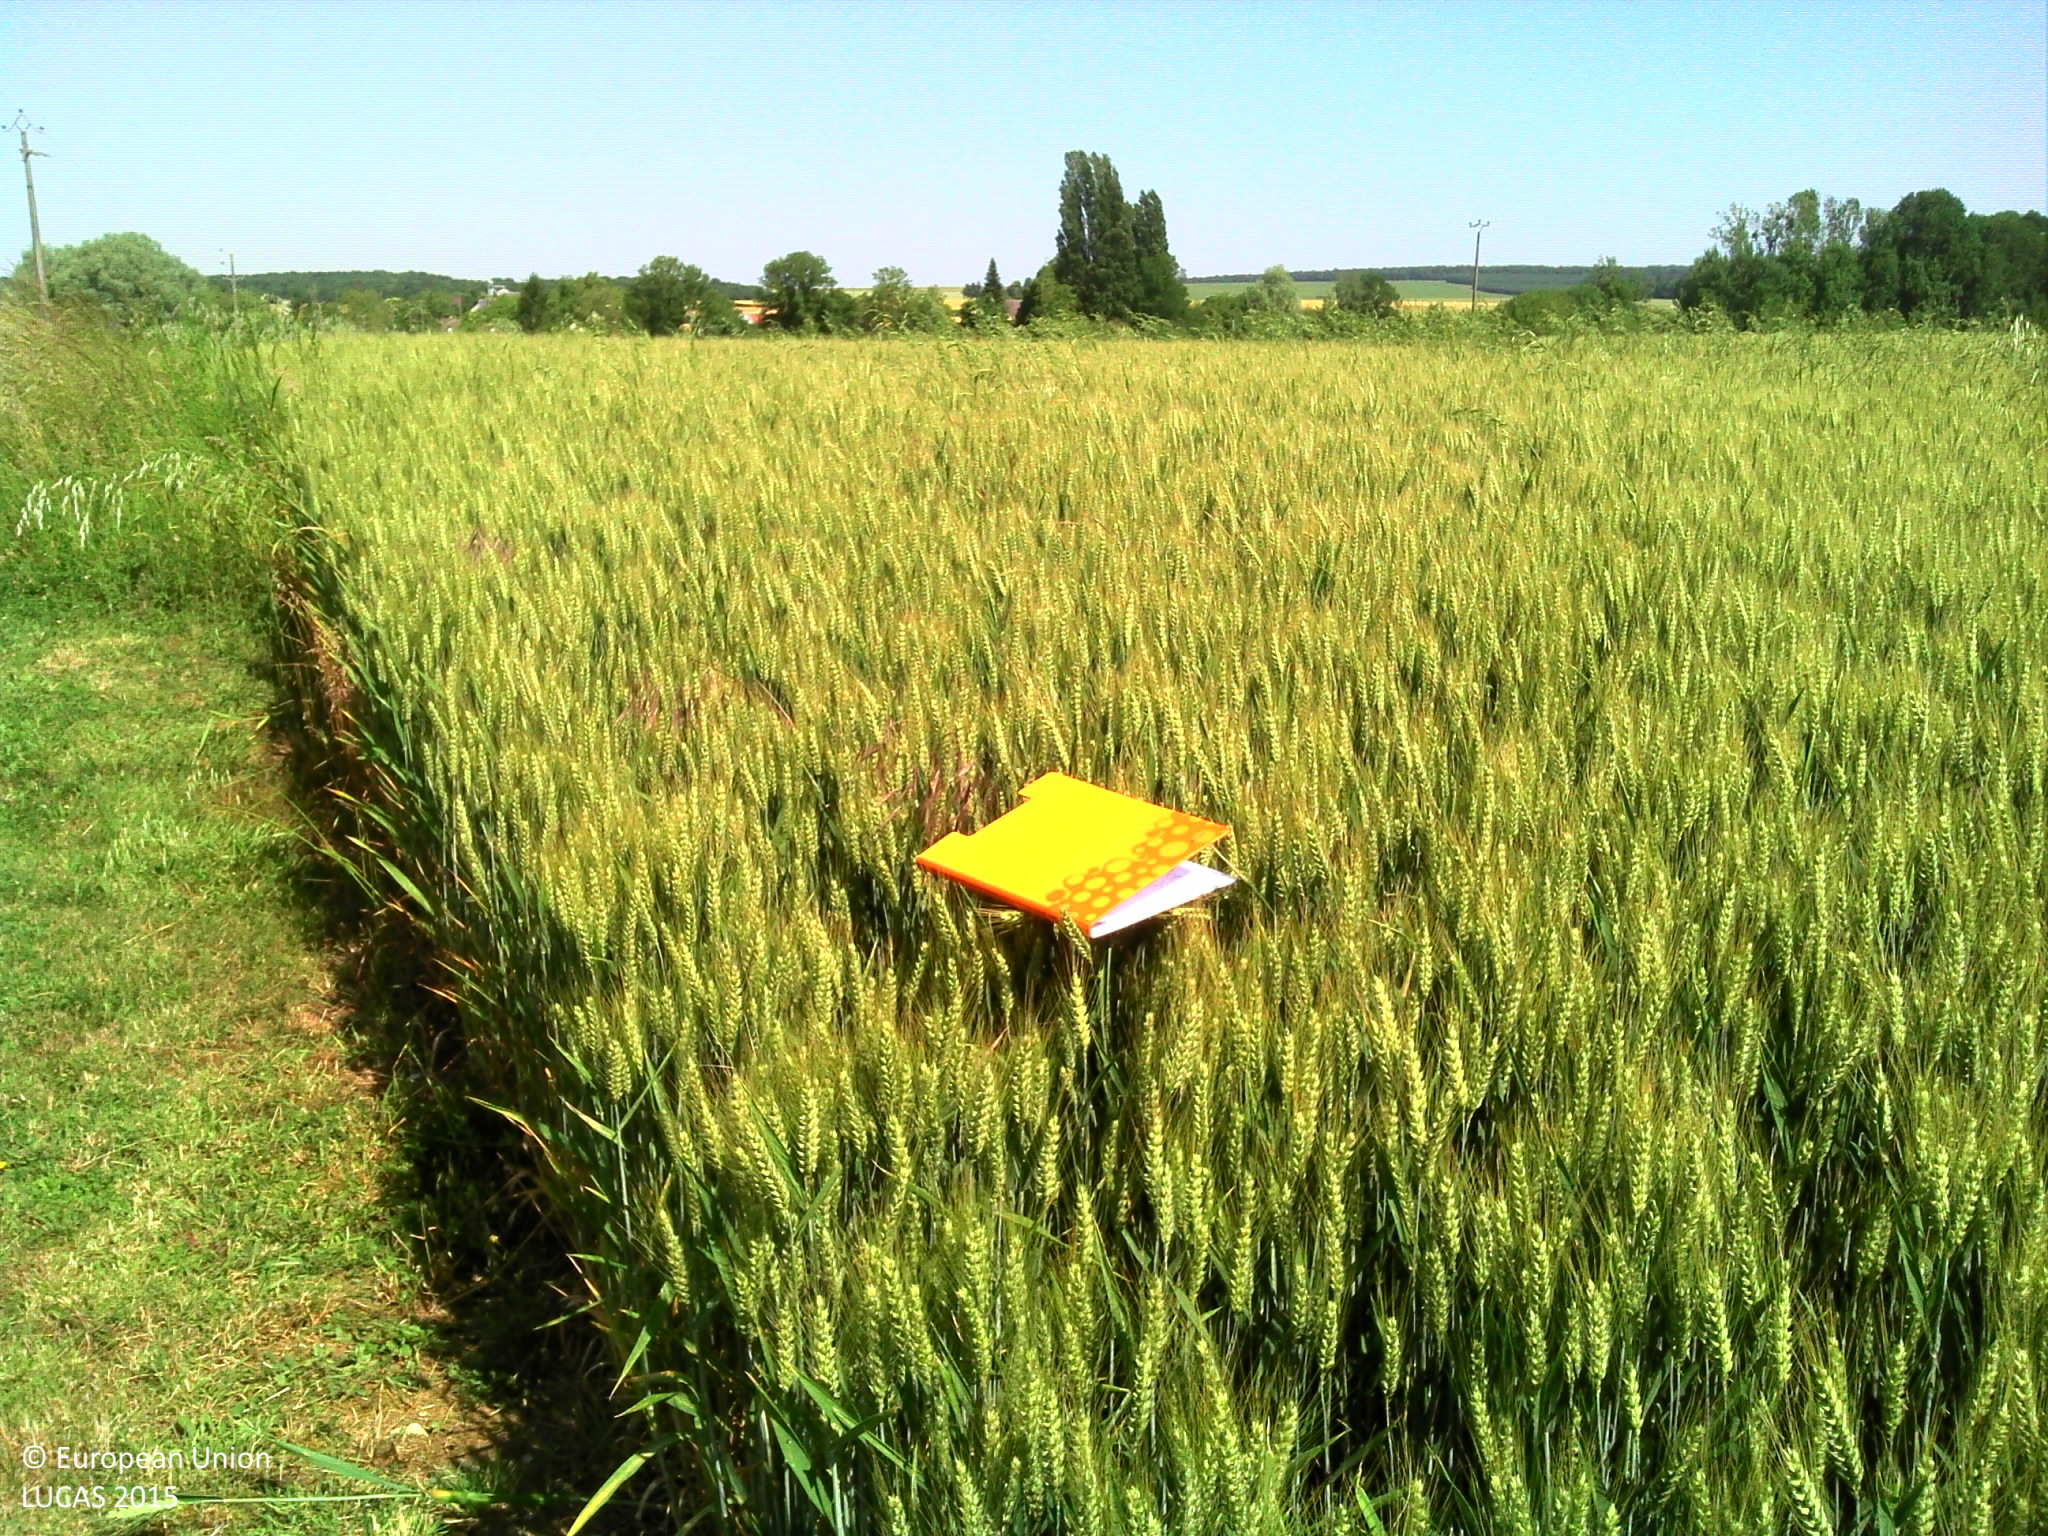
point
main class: Cropland
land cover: Common wheat
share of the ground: > 75 %
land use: Agriculture (excluding fallow land and kitchen gardens)
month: June
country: FR
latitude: 47.0947
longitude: 2.6822
